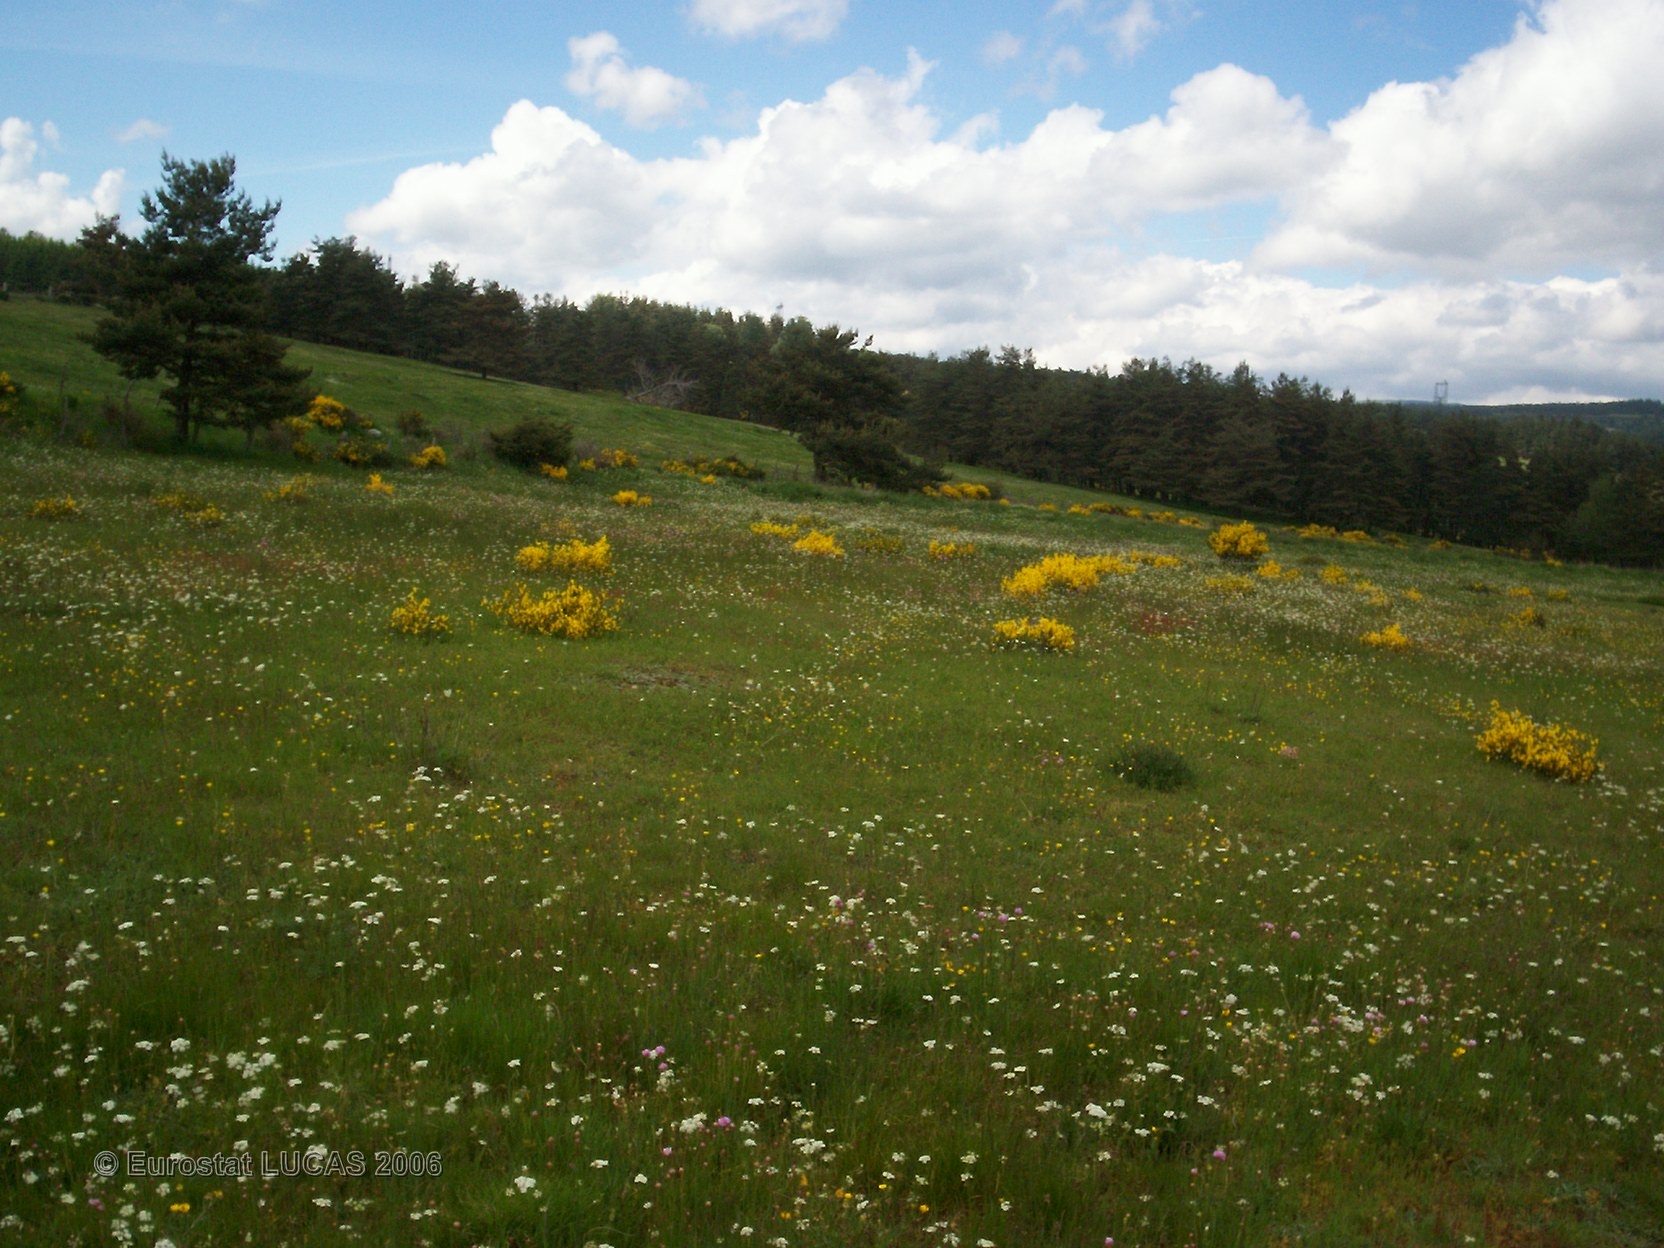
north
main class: Grassland
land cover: Grassland without tree/shrub cover
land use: Agriculture (excluding fallow land and kitchen gardens)
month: May
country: FR
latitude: 44.7911
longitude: 3.3932
